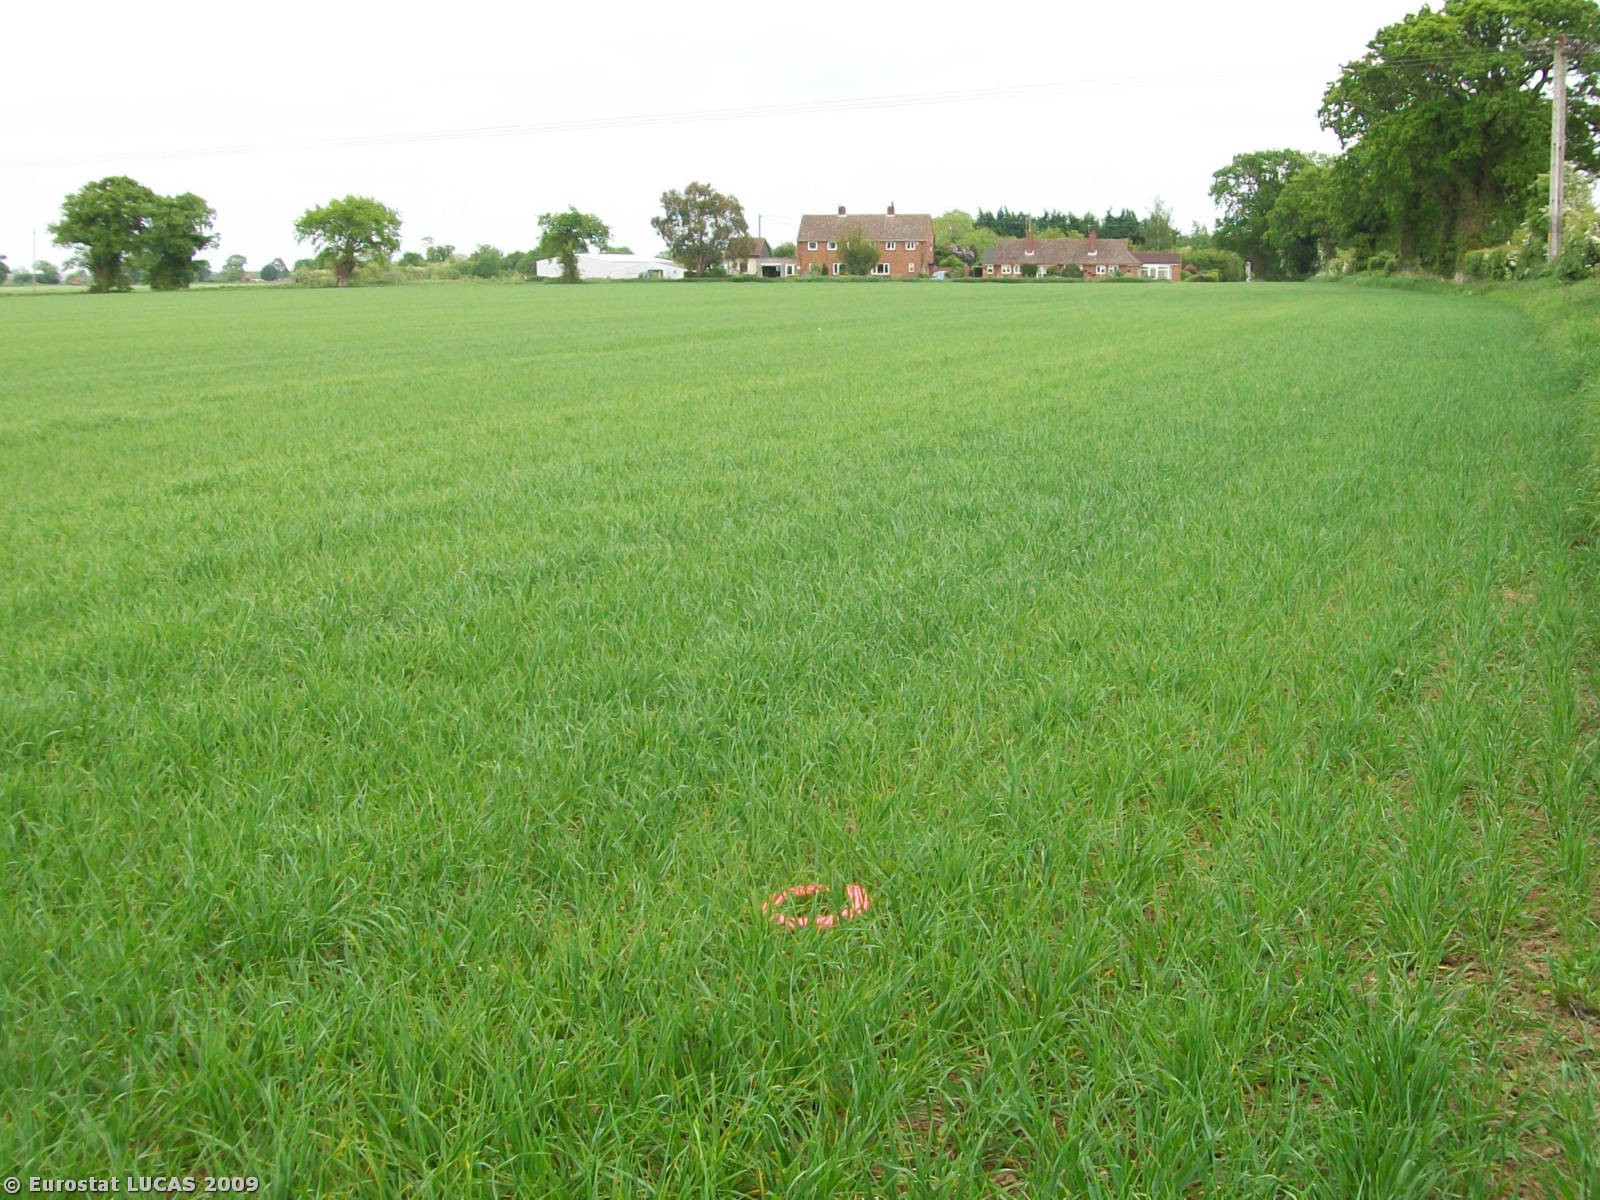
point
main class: Cropland
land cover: Common wheat
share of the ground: > 75 %
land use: Agriculture (excluding fallow land and kitchen gardens)
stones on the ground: < 10 %
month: May
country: GB
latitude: 52.7250
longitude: 1.5267
